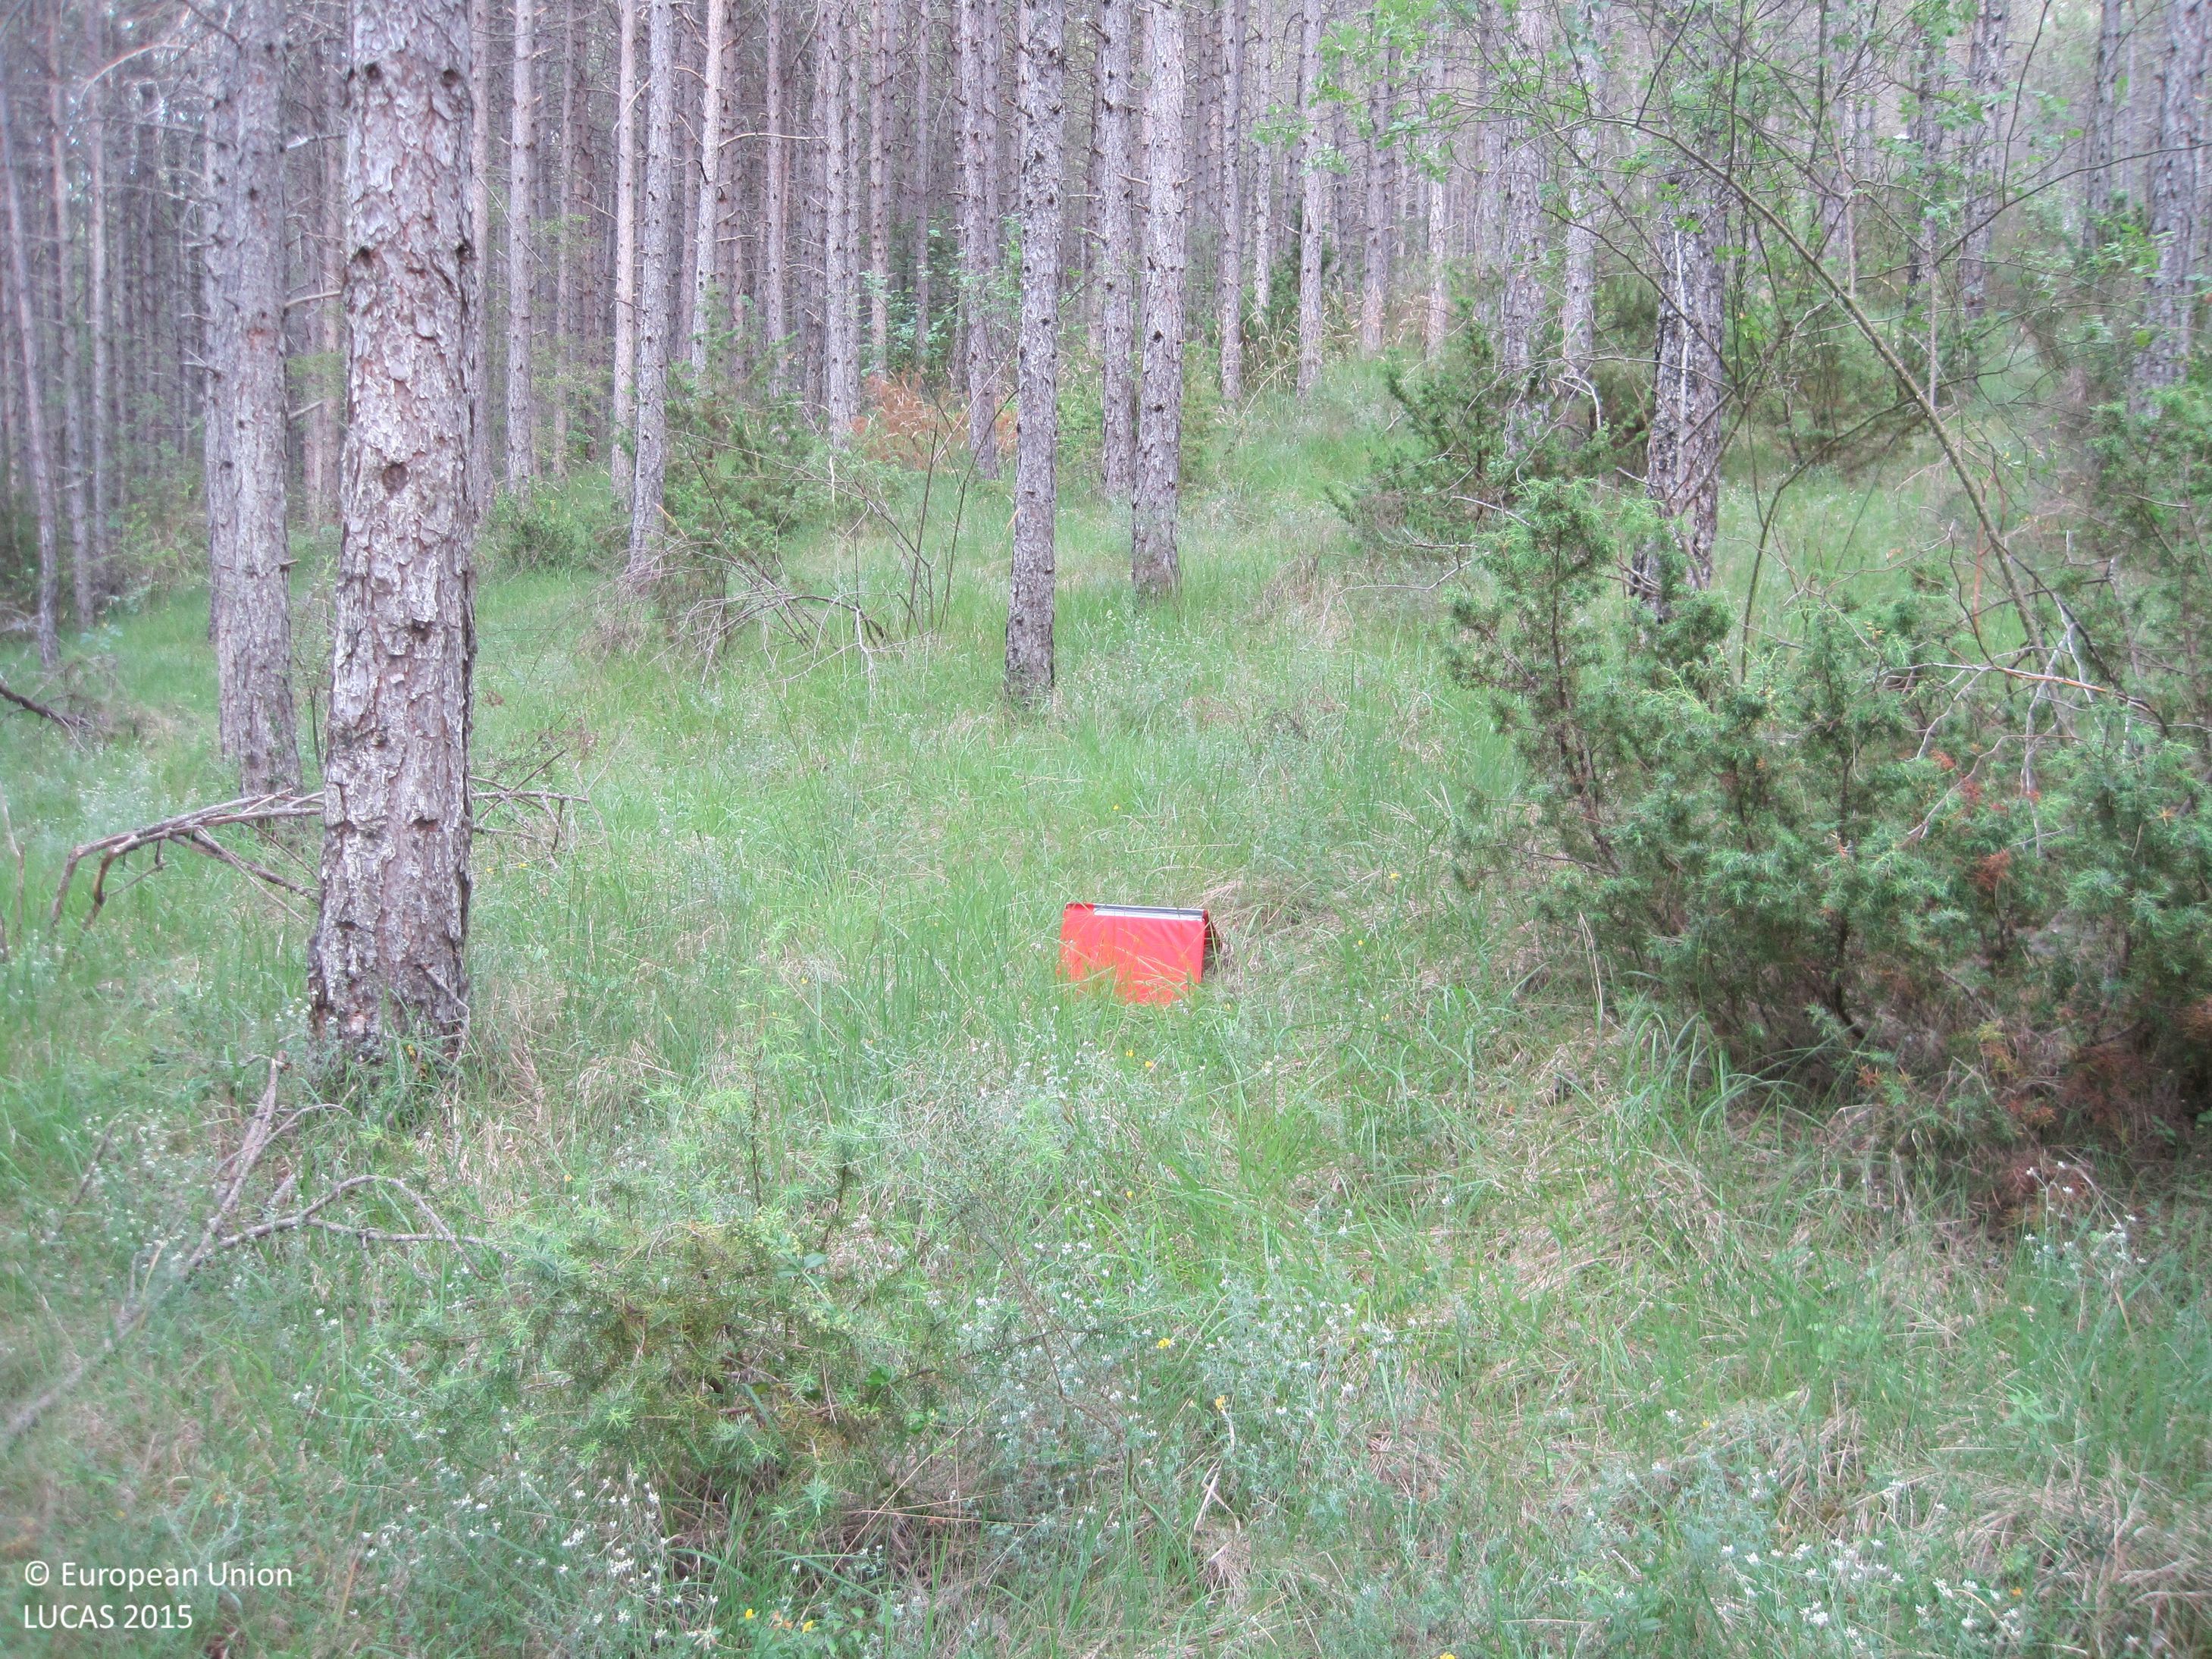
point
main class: Woodland
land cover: Pine dominated coniferous woodland
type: coniferous forest of the mediterranean region
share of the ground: > 75 %
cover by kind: coniferous forest trees 95 %, herbaceous plants 5 %
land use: Forestry
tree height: > 5 m
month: June
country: ES
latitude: 42.7729
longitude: -1.2421
